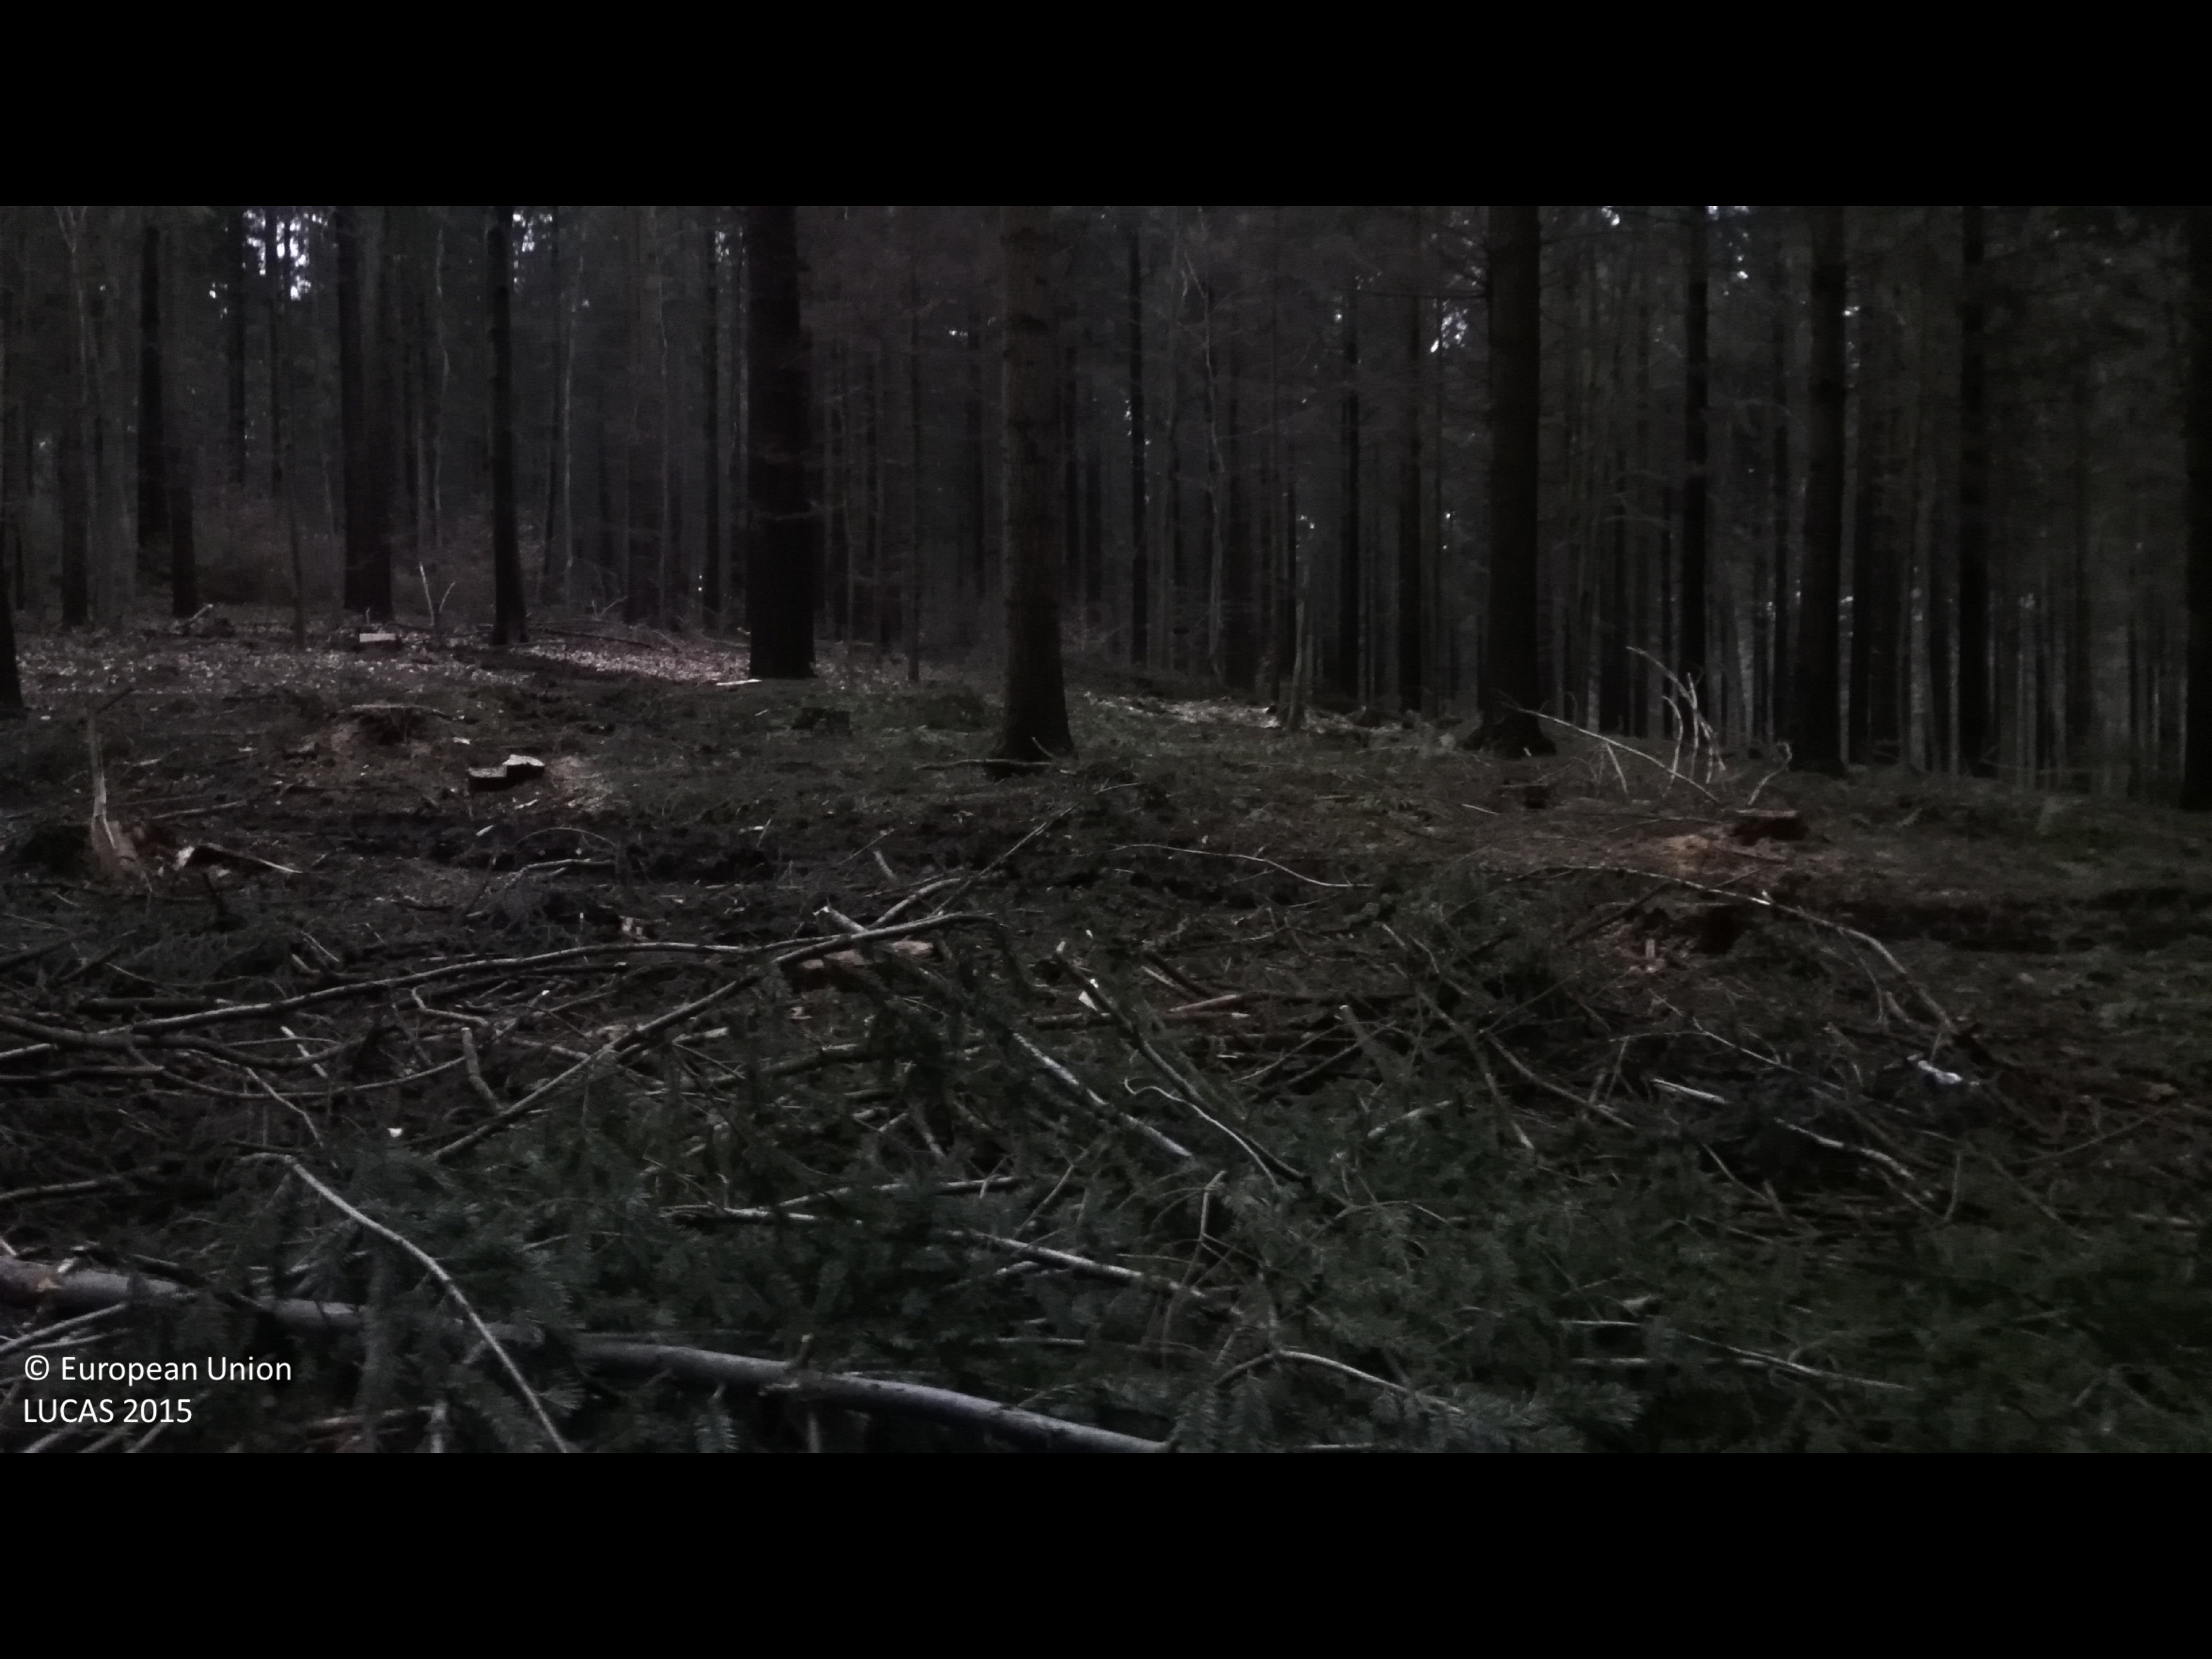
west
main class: Woodland
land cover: Pine dominated coniferous woodland
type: hemiboreal forest and nemoral coniferous forest and mixed broadleaved-coniferous forest
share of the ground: > 75 %
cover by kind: coniferous forest trees 100 %
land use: Forestry
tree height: > 5 m
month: January
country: DE
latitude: 53.4199
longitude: 9.9248
